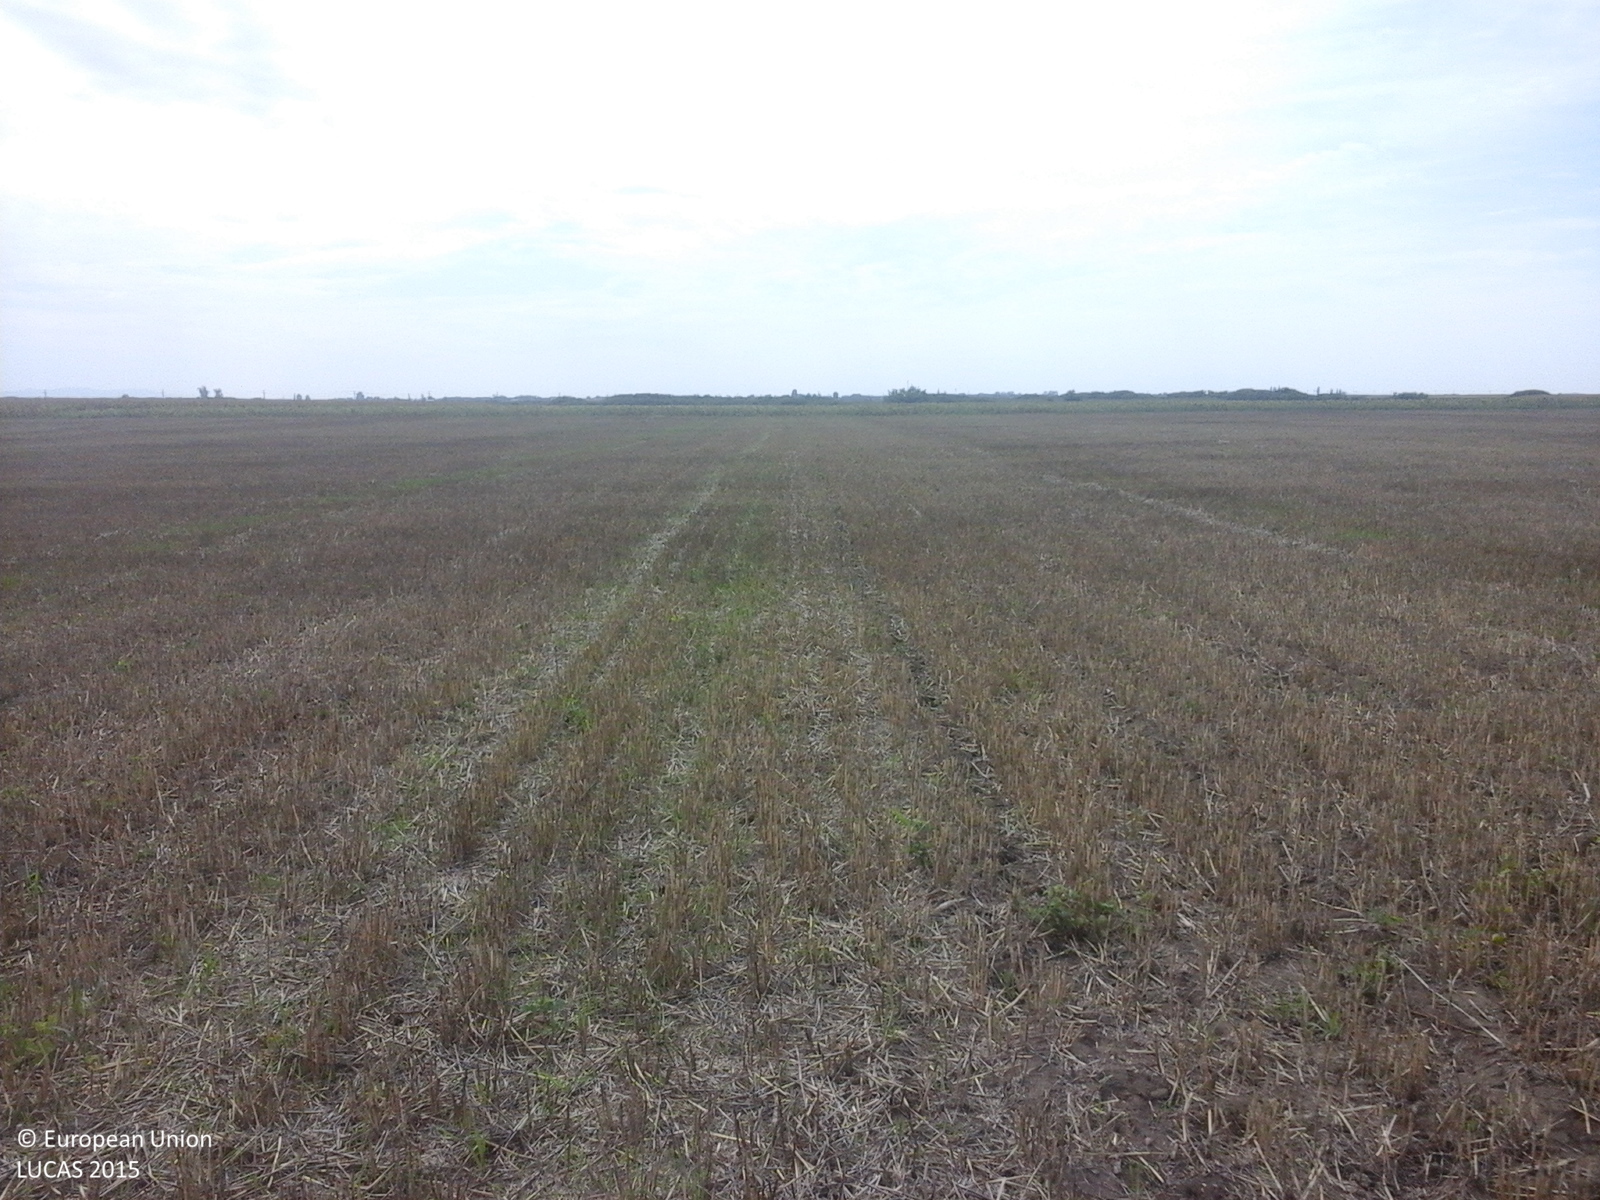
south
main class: Cropland
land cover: Common wheat
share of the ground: 25 - 50 %
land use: Agriculture (excluding fallow land and kitchen gardens)
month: August
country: RO
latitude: 46.4608
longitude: 21.4564
